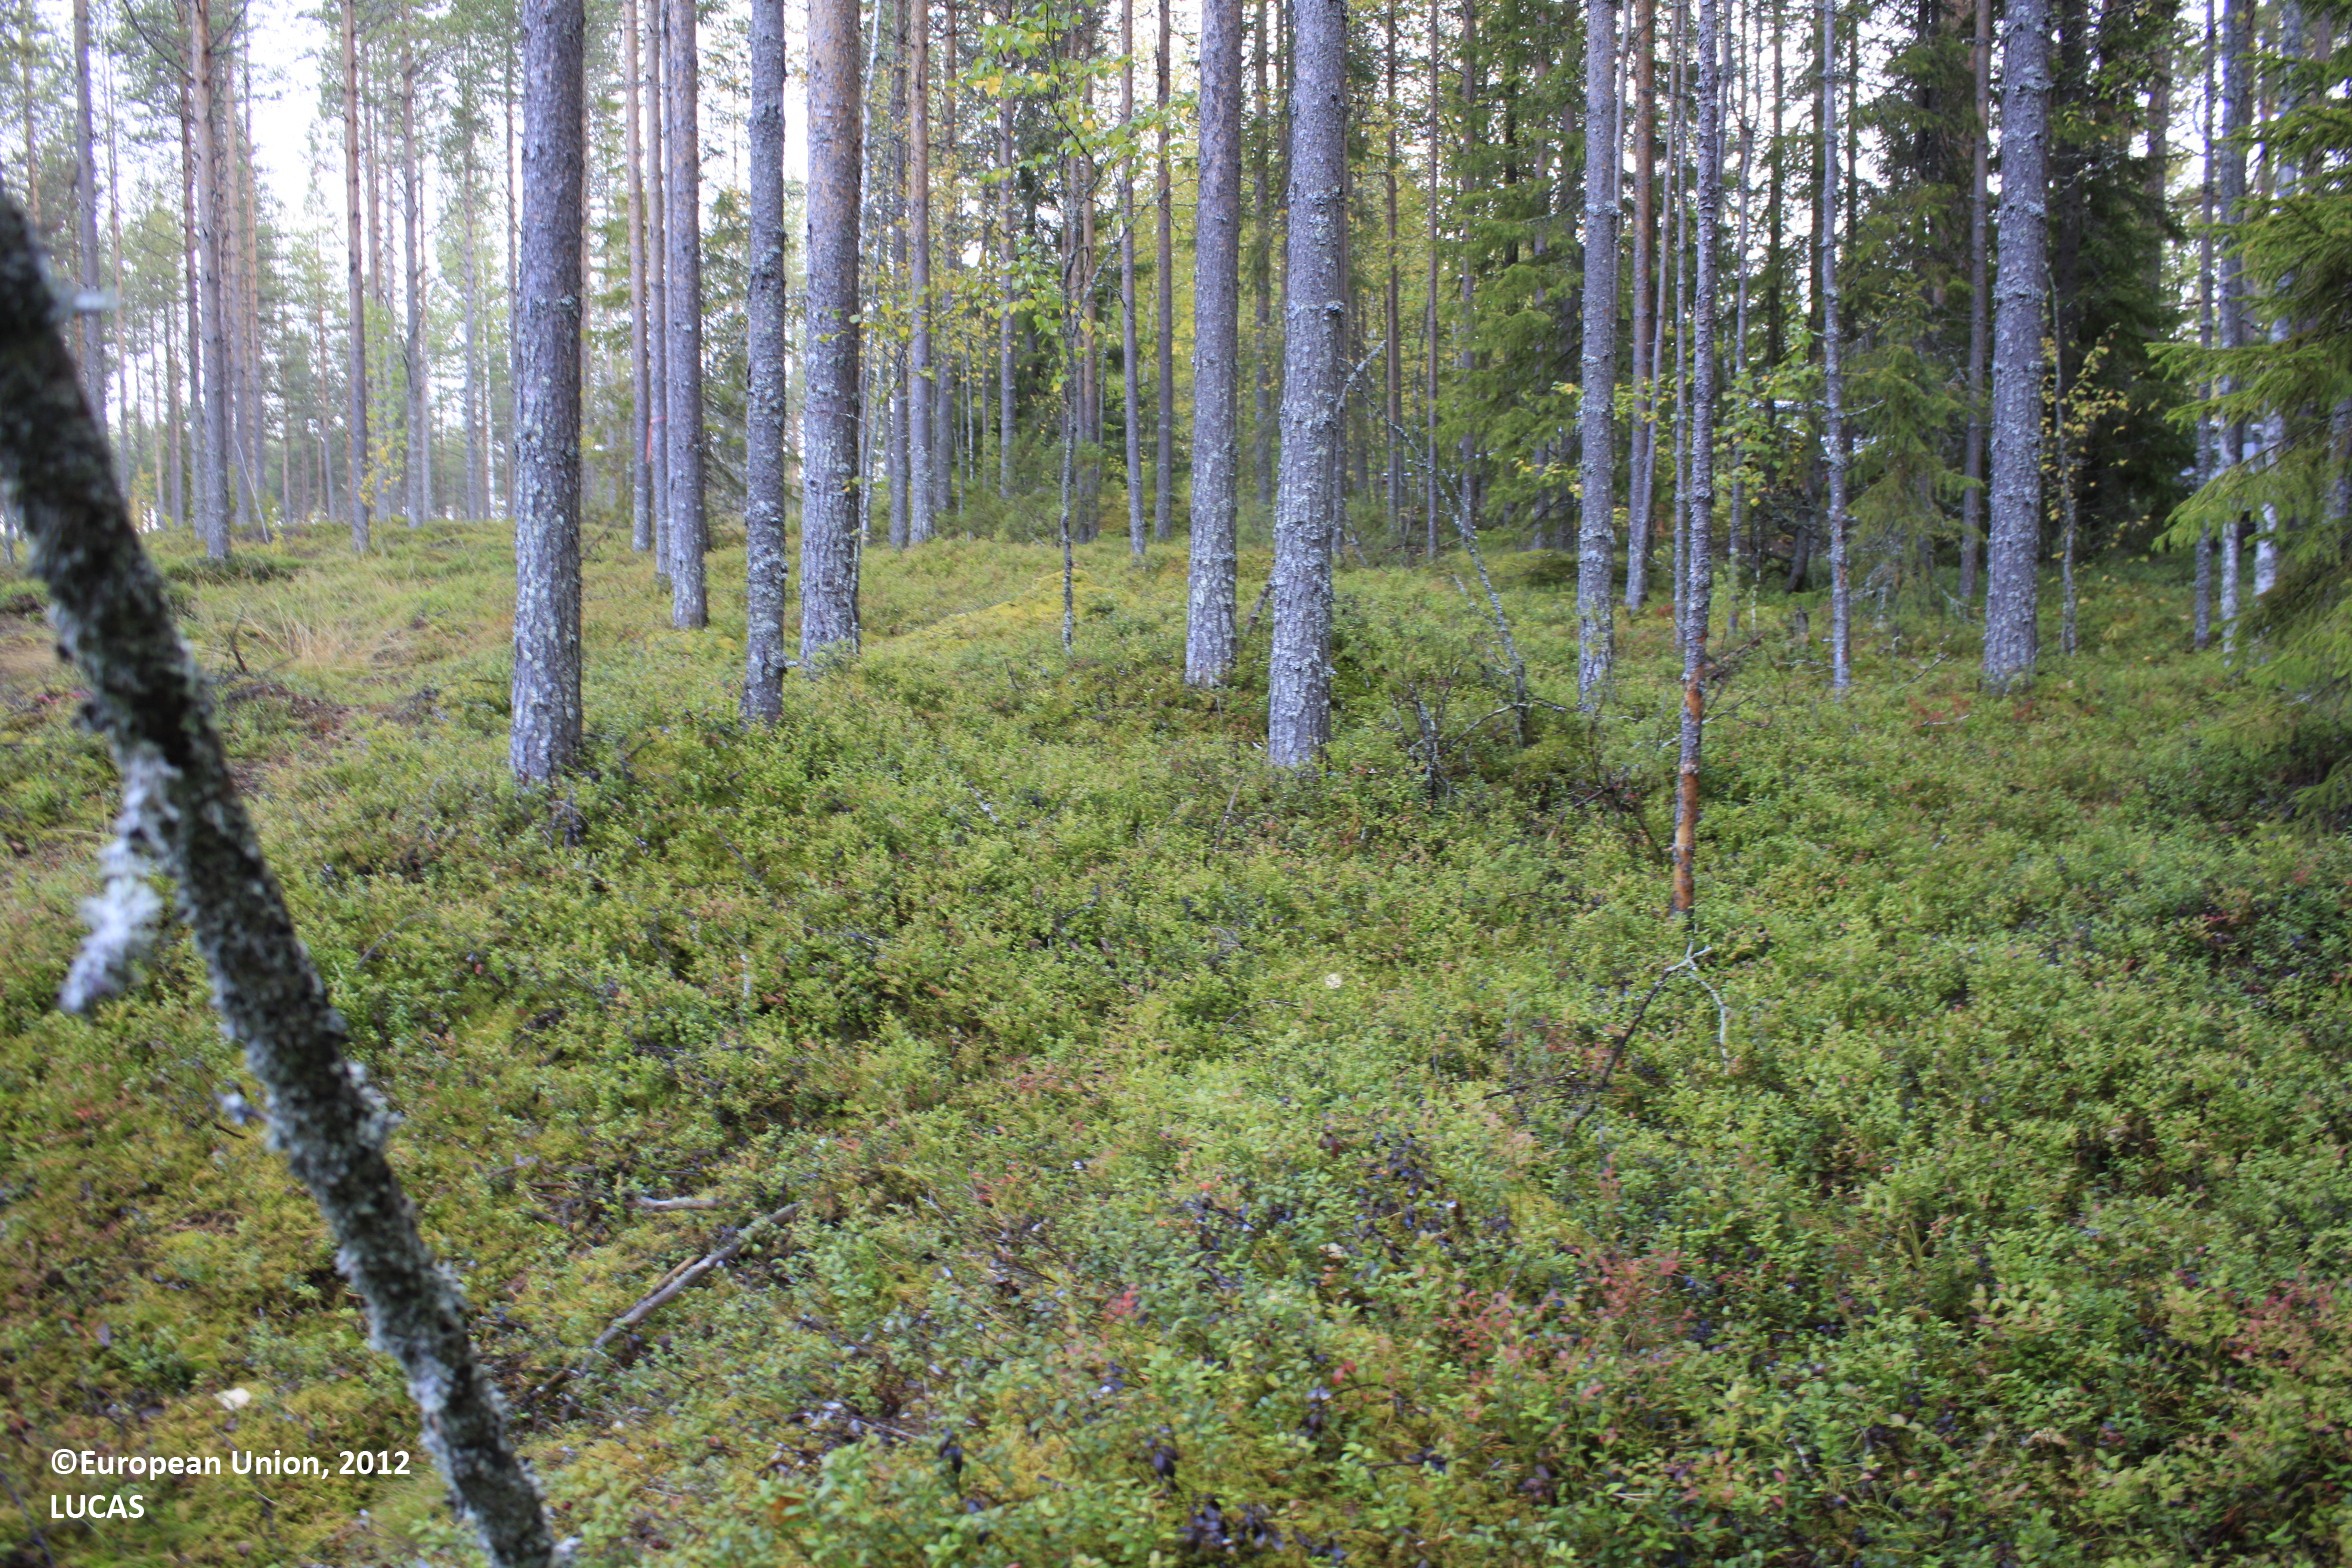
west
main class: Woodland
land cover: Pine dominated mixed woodland
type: boreal forest
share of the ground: 50 - 75 %
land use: Forestry
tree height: > 5 m
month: September
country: FI
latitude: 65.6977
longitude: 26.6747
